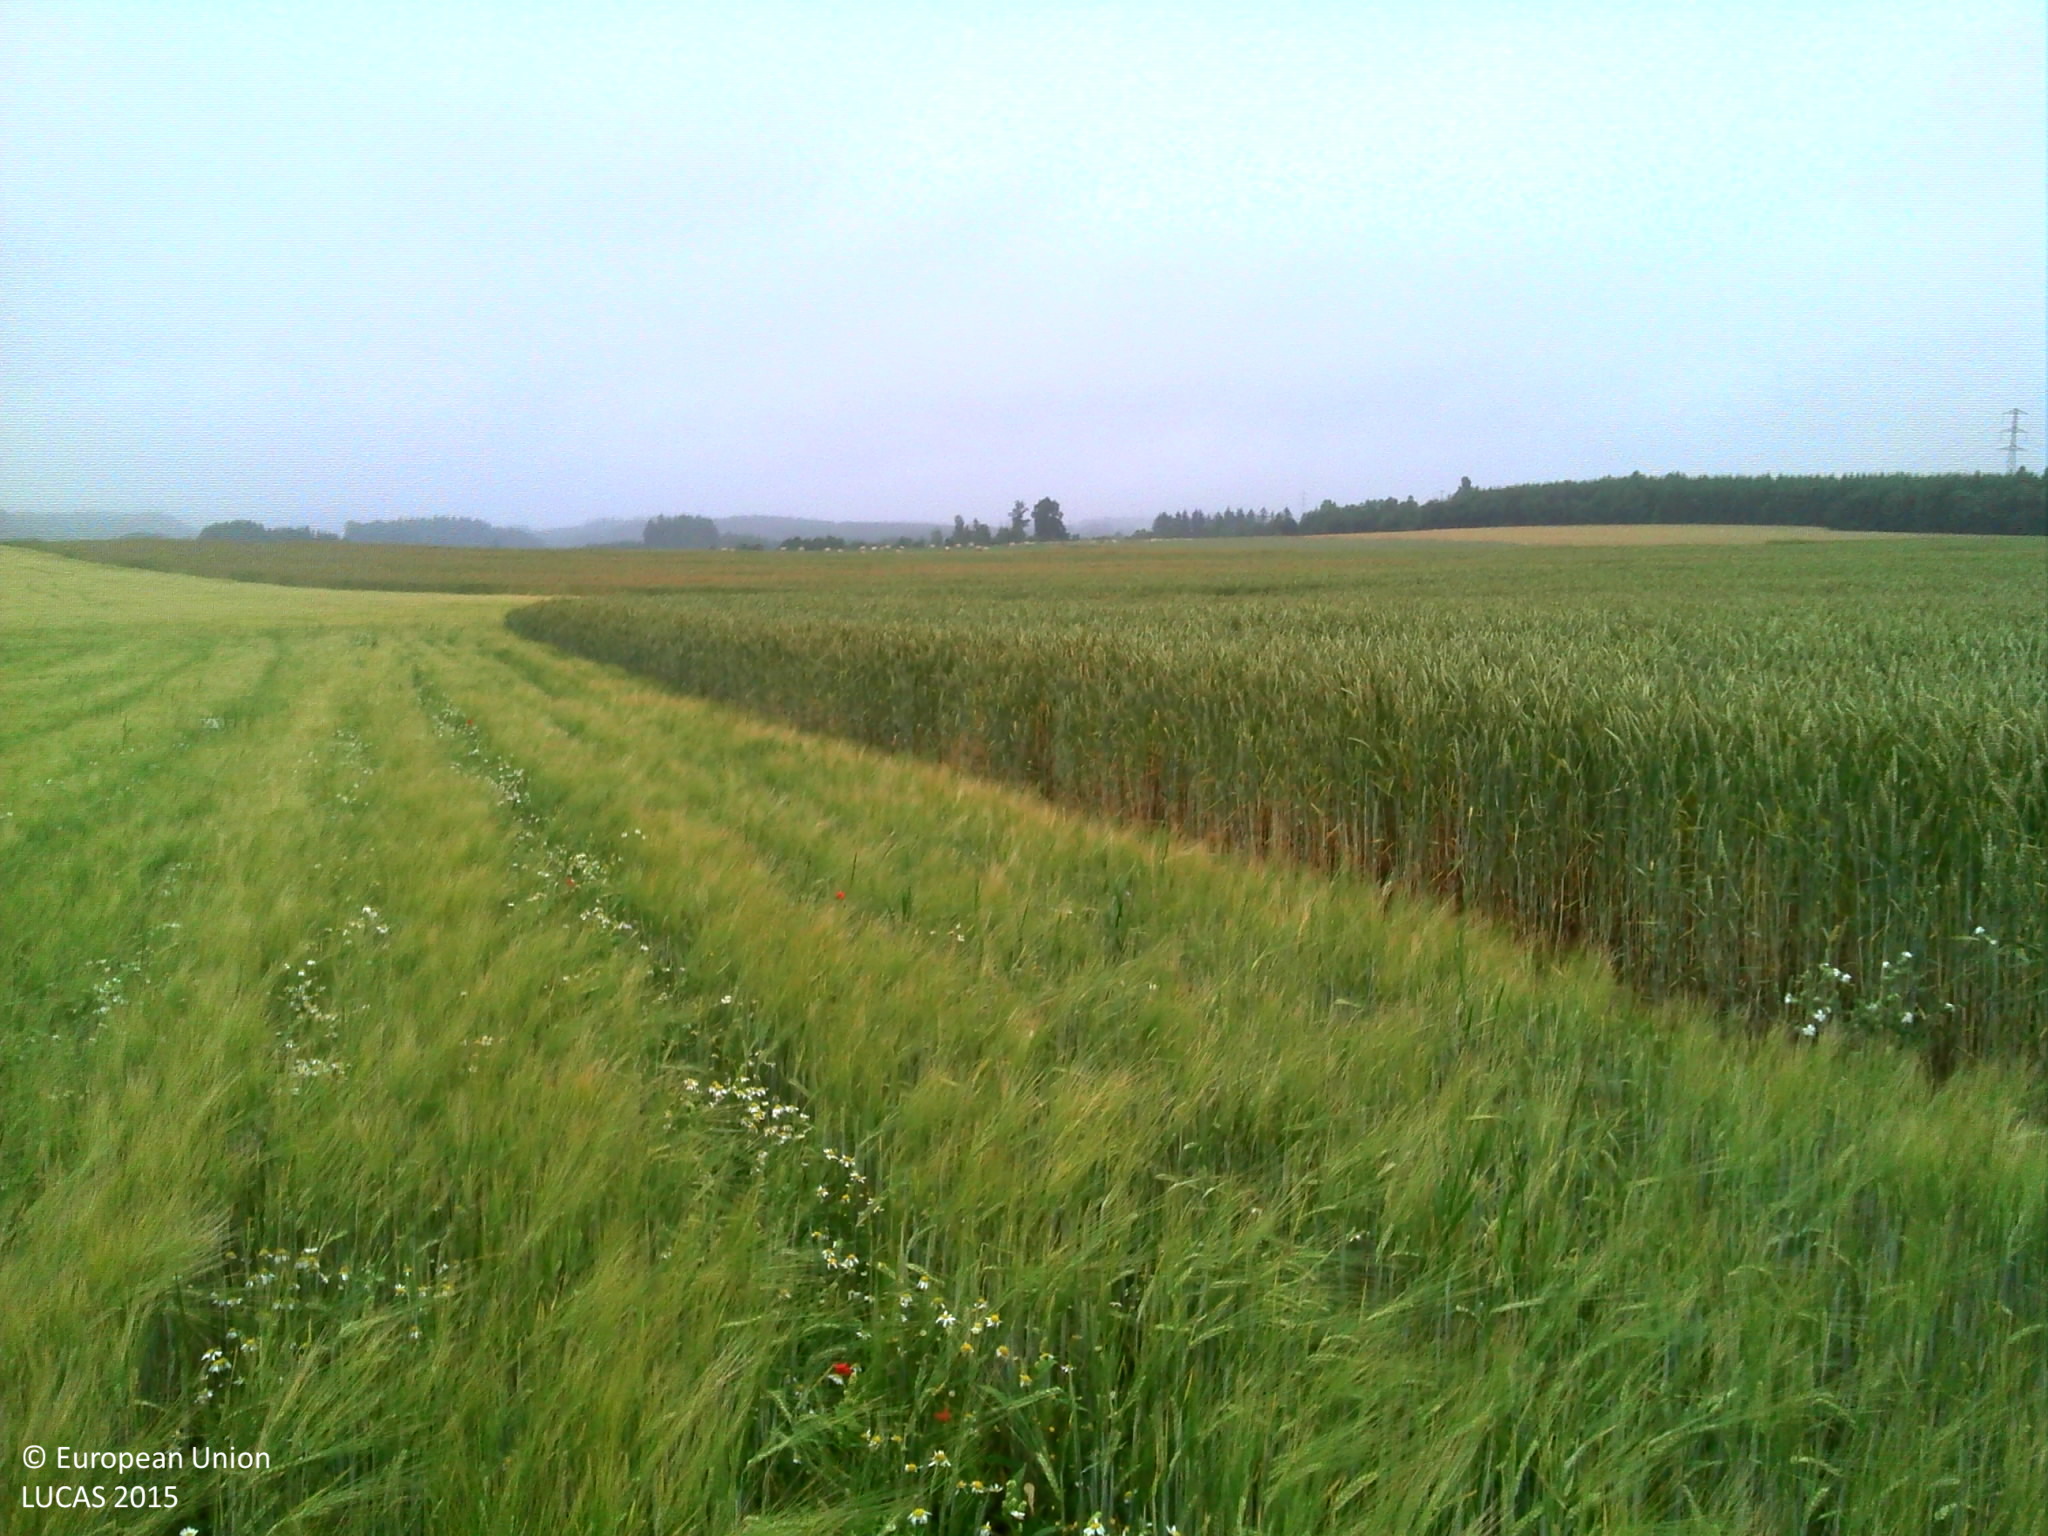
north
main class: Cropland
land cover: Barley
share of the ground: > 75 %
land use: Agriculture (excluding fallow land and kitchen gardens)
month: July
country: BE
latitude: 50.0654
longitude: 5.6539
